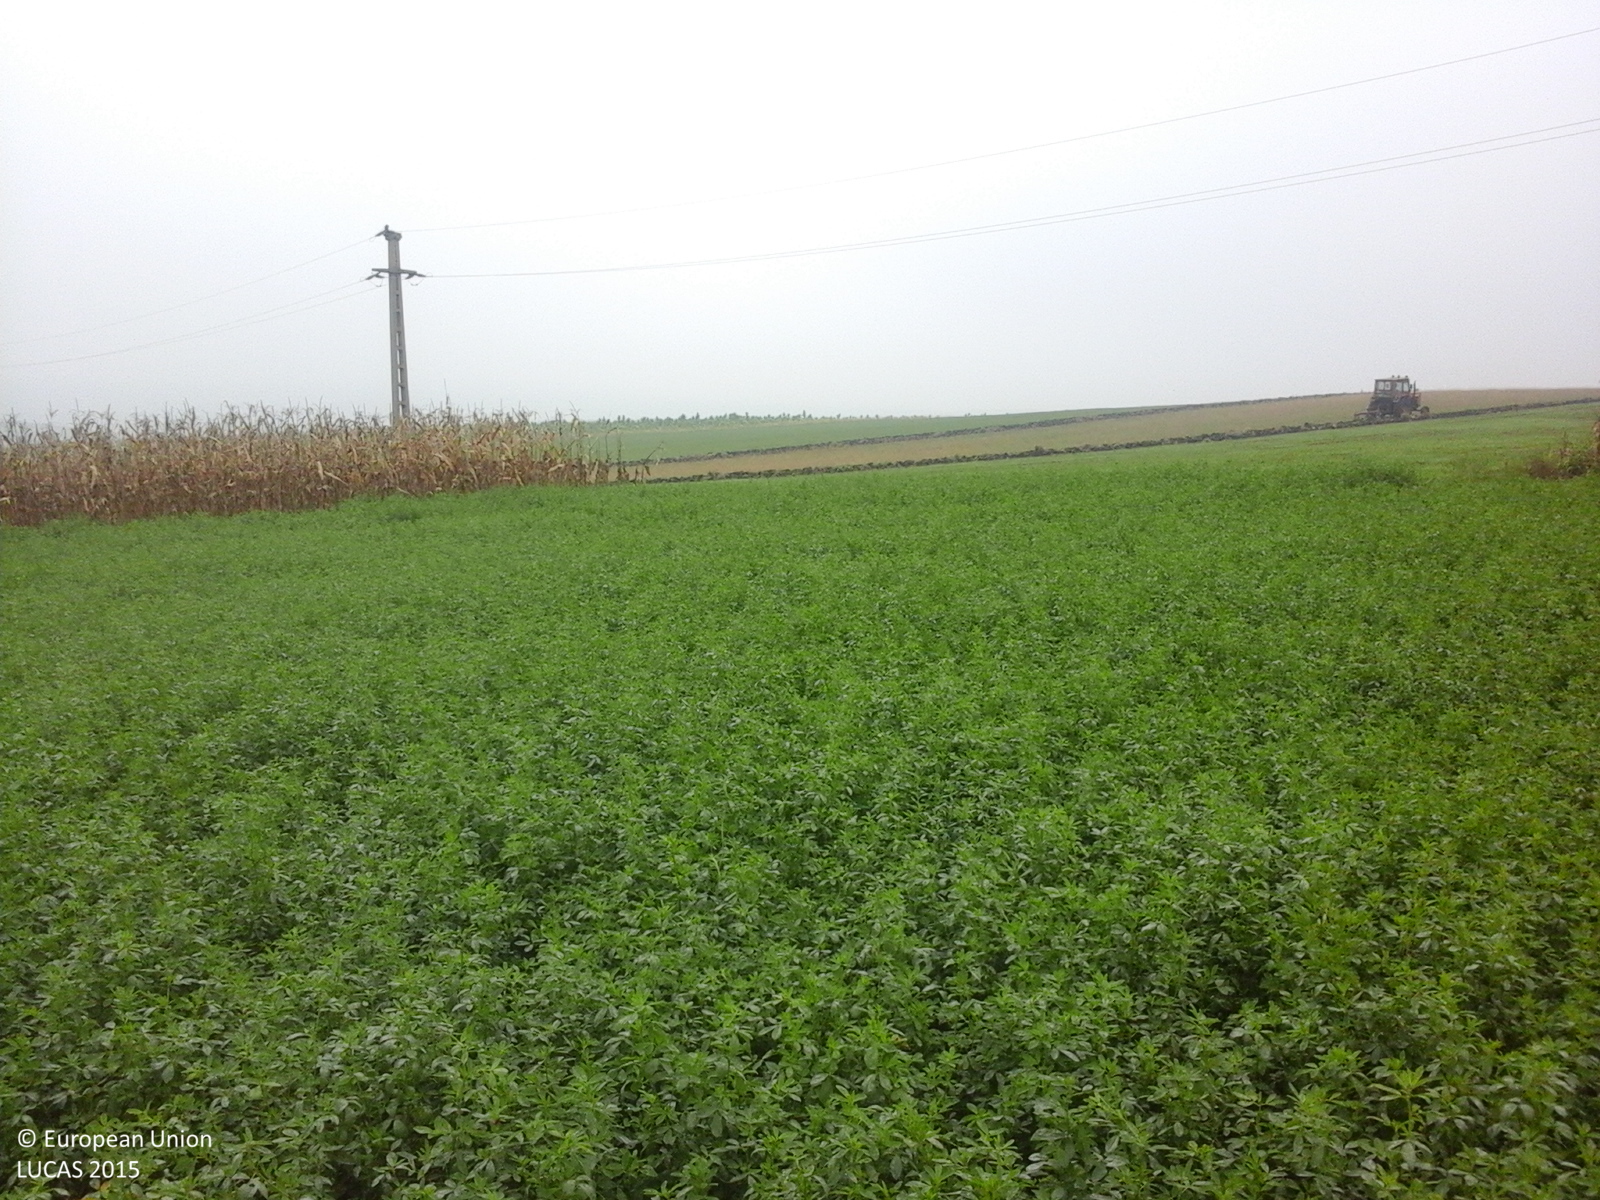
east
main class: Cropland
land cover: Lucerne
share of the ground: > 75 %
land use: Agriculture (excluding fallow land and kitchen gardens)
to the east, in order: Lucerne; Maize; Tracks; Lucerne; Electric lines; Lucerne; Grassland without tree/shrub cover; Lucerne; Tobacco; Tracks; Tobacco; Maize
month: October
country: RO
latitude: 46.5662
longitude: 24.2103
